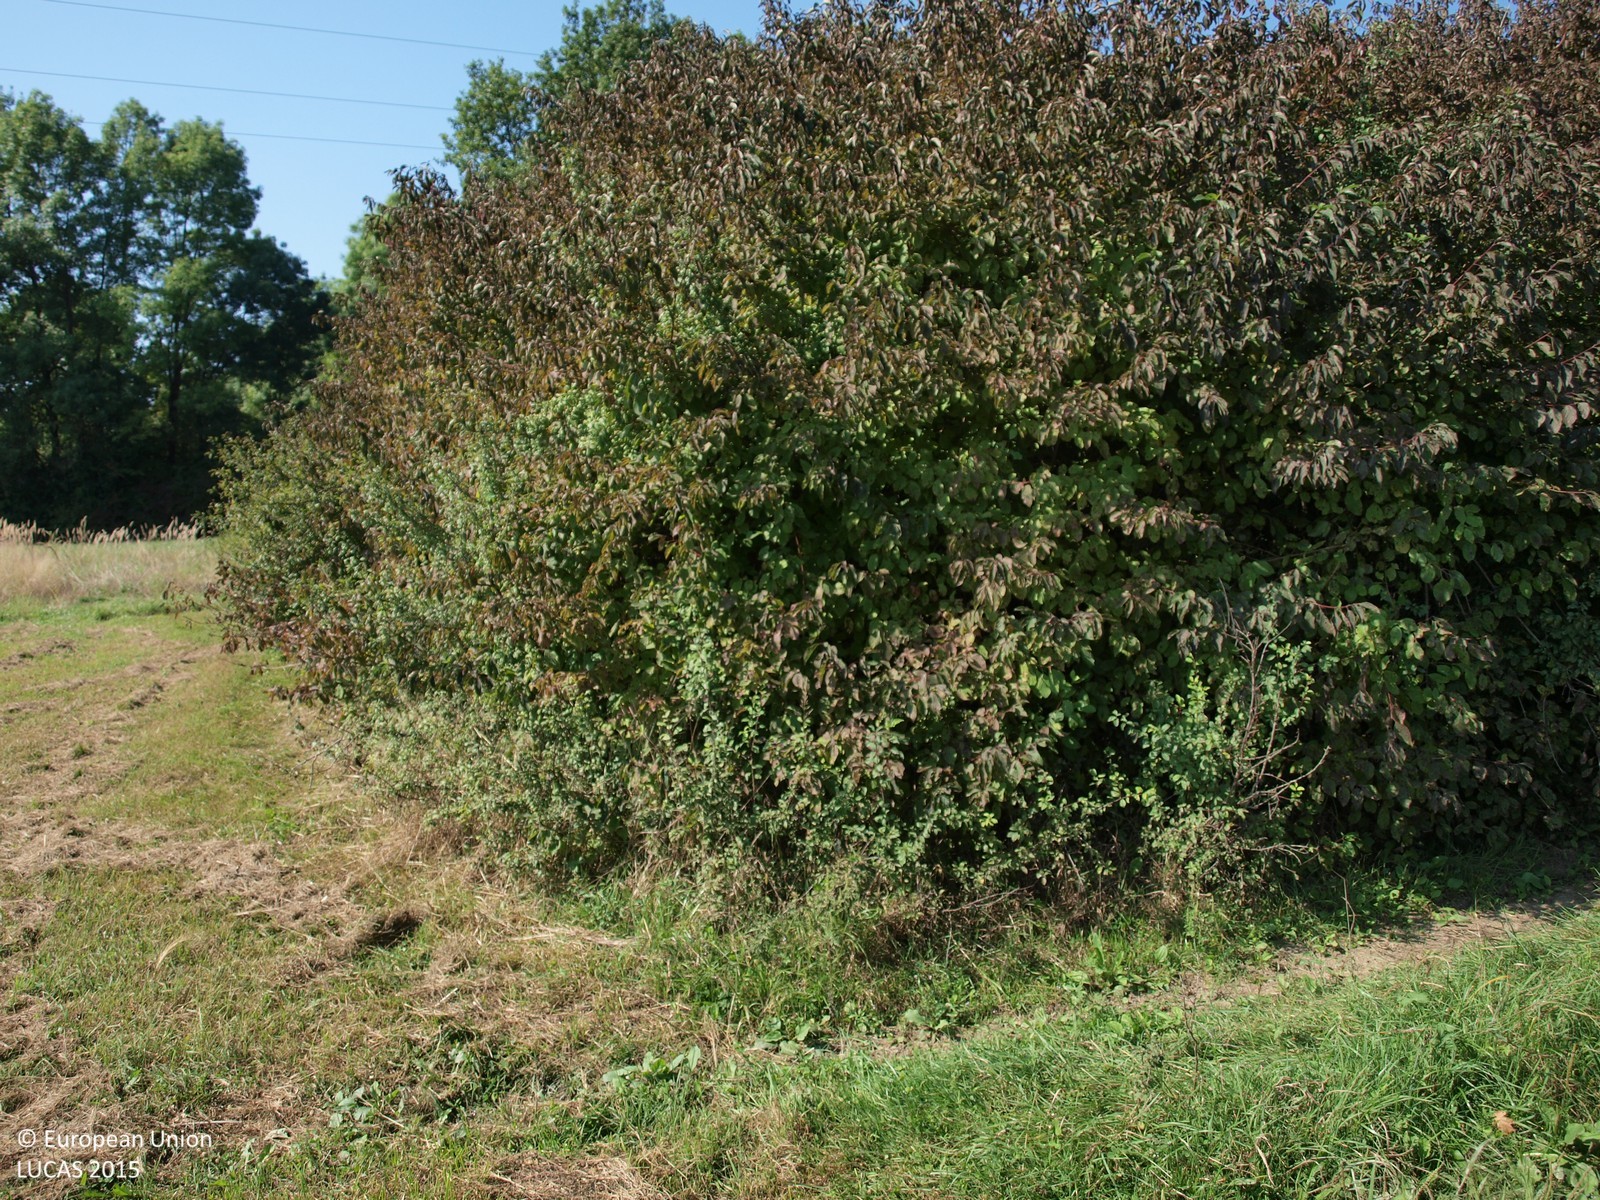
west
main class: Grassland
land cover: Grassland without tree/shrub cover
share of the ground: > 75 %
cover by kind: herbaceous plants 100 %
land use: Agriculture (excluding fallow land and kitchen gardens)
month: September
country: HR
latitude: 45.6432
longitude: 16.2720
